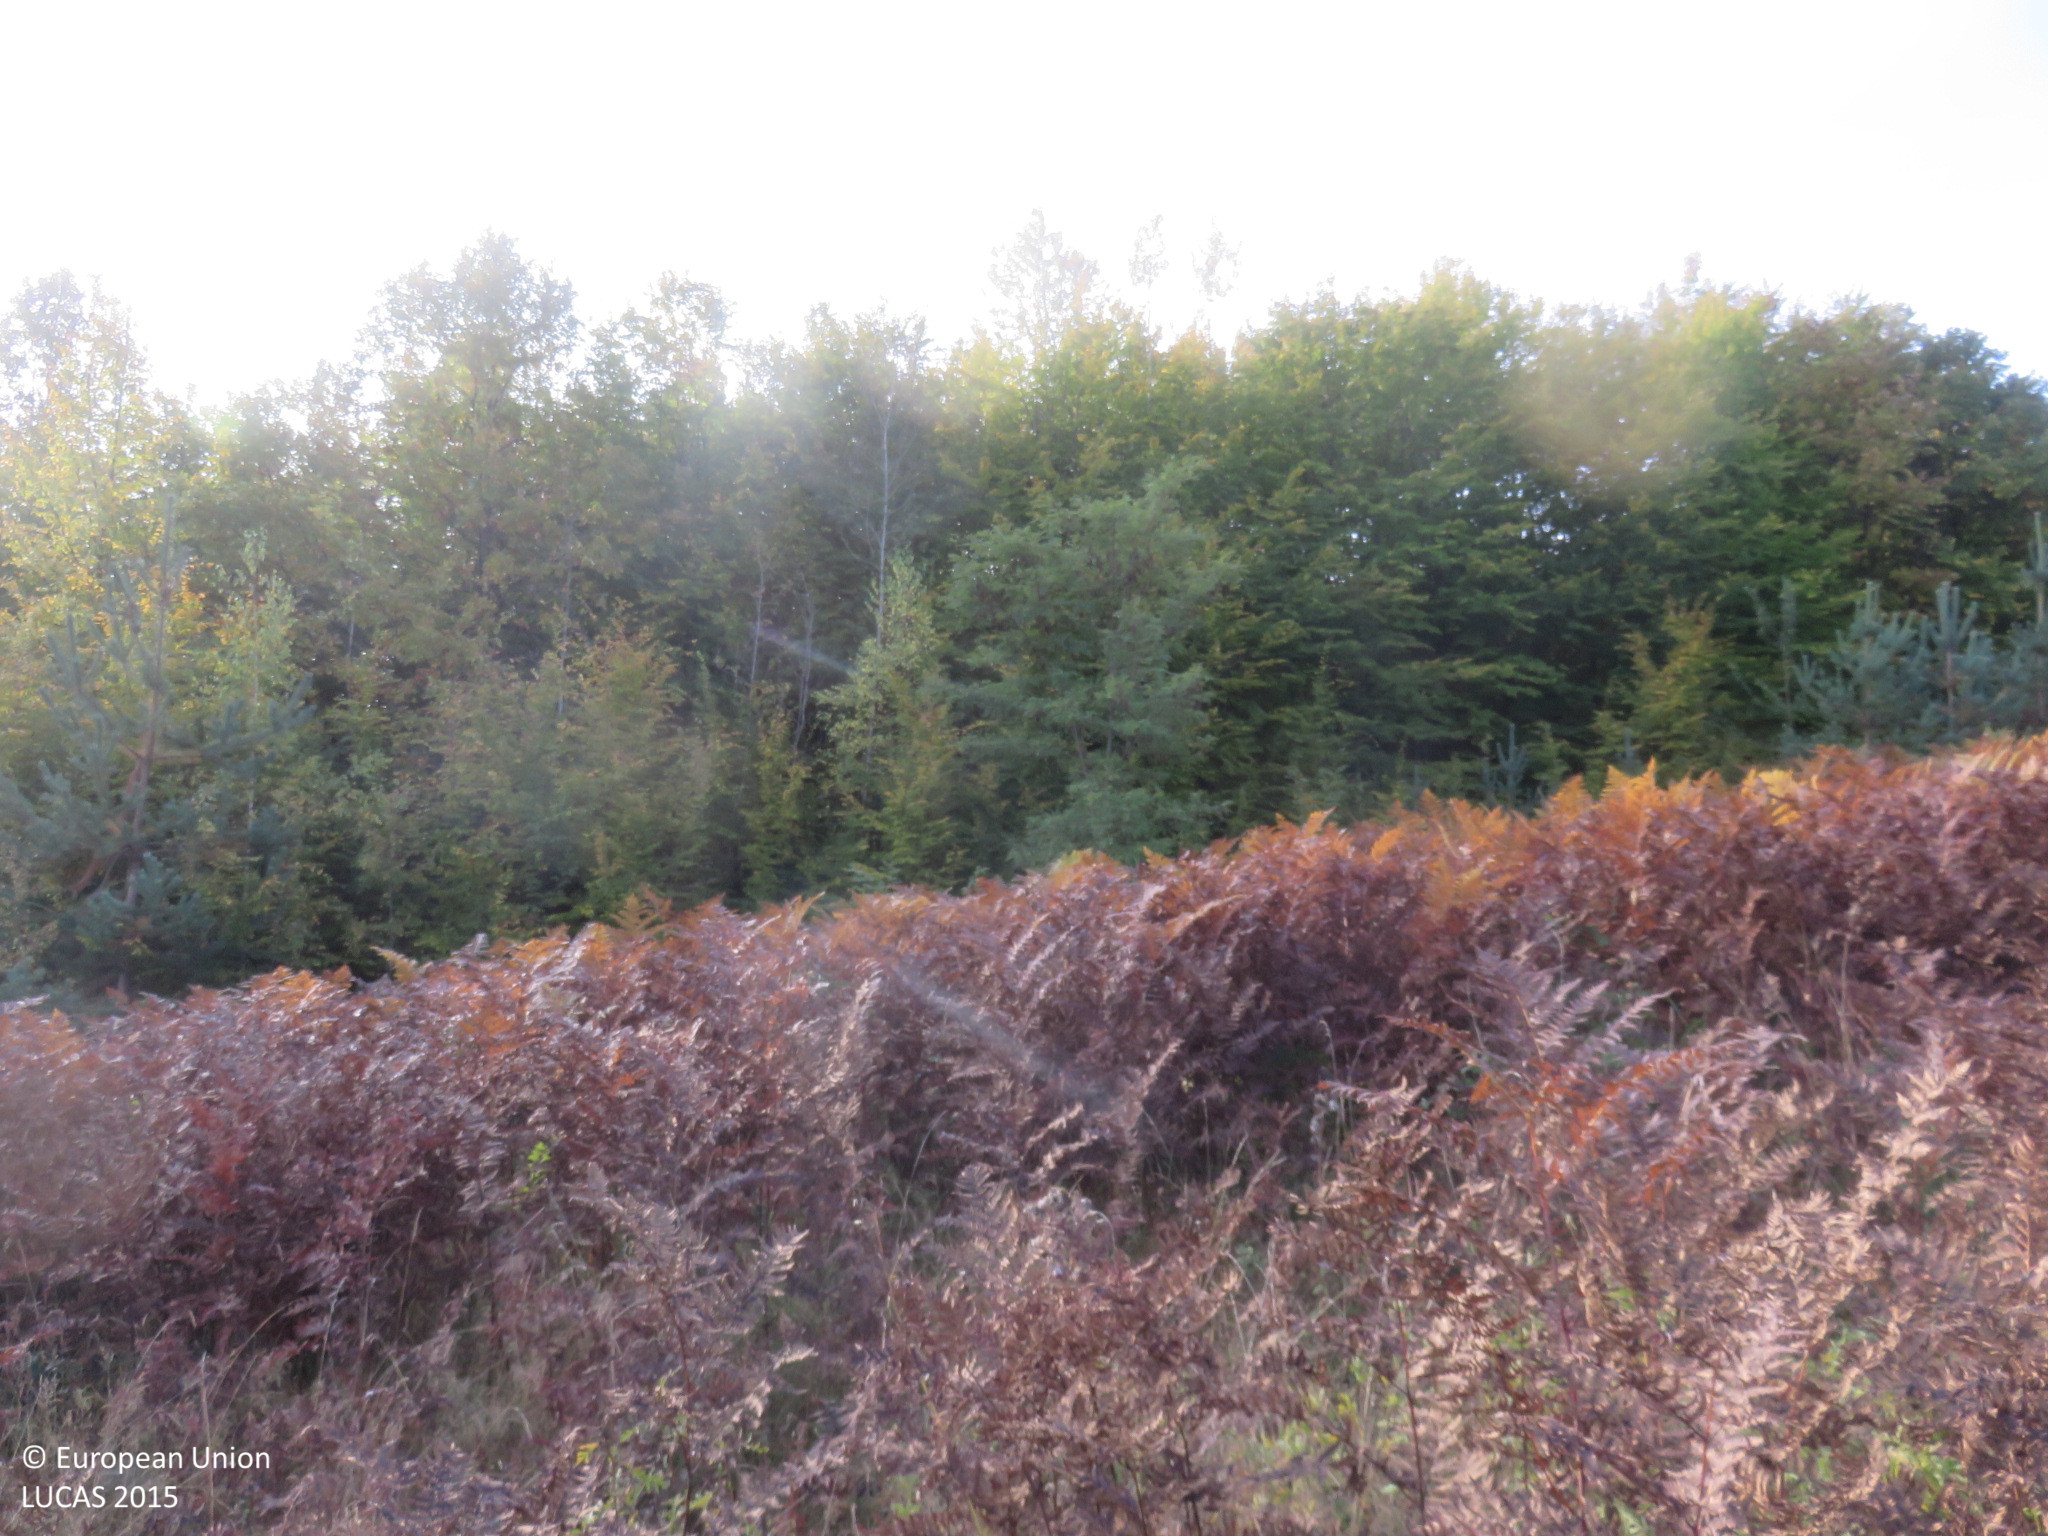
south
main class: Grassland
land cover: Grassland with sparse tree/shrub cover
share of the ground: > 75 %
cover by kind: herbaceous plants 90 %, broadleaved forest trees 5 %, shrubs 5 %
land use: Abandoned areas
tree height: < 5 m
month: October
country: BG
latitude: 42.8951
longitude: 24.8175
